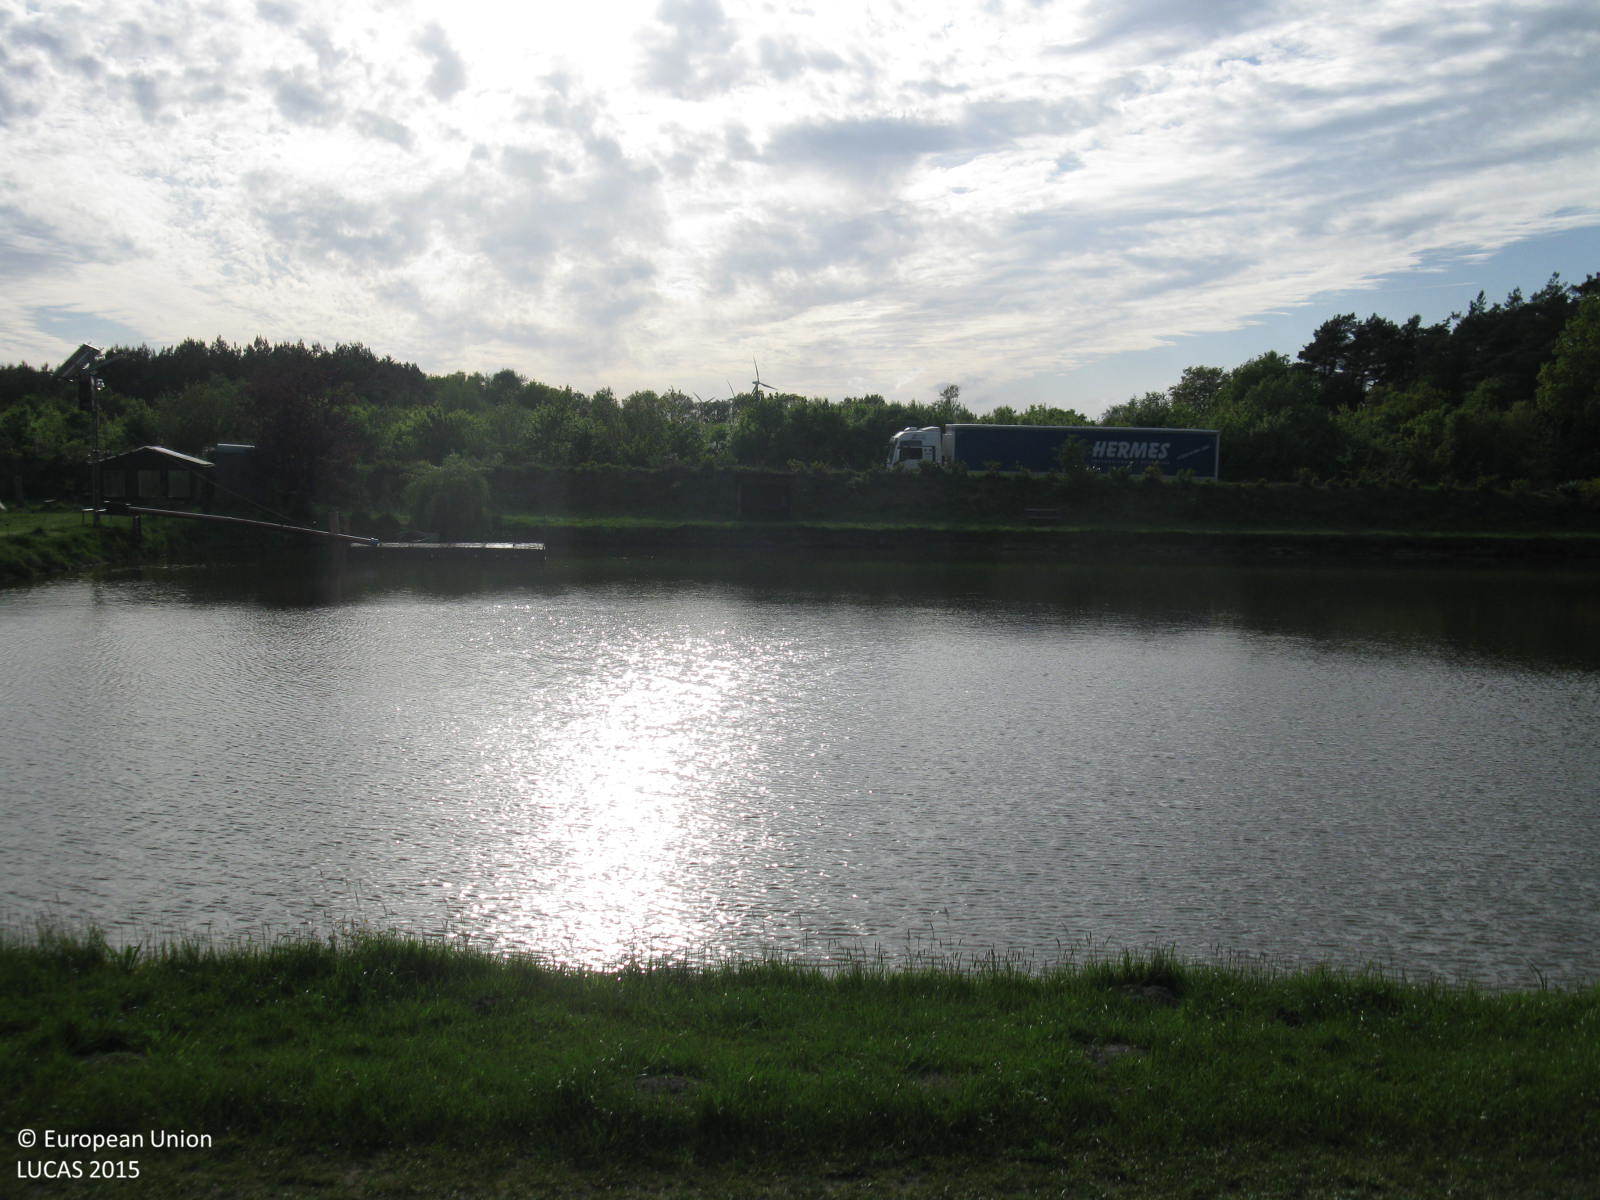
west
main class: Woodland
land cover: Broadleaved woodland
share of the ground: 25 - 50 %
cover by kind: broadleaved forest trees 50 %, herbaceous plants 50 %
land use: Semi-natural and natural areas not in use
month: May
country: DE
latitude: 52.9603
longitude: 7.3953
